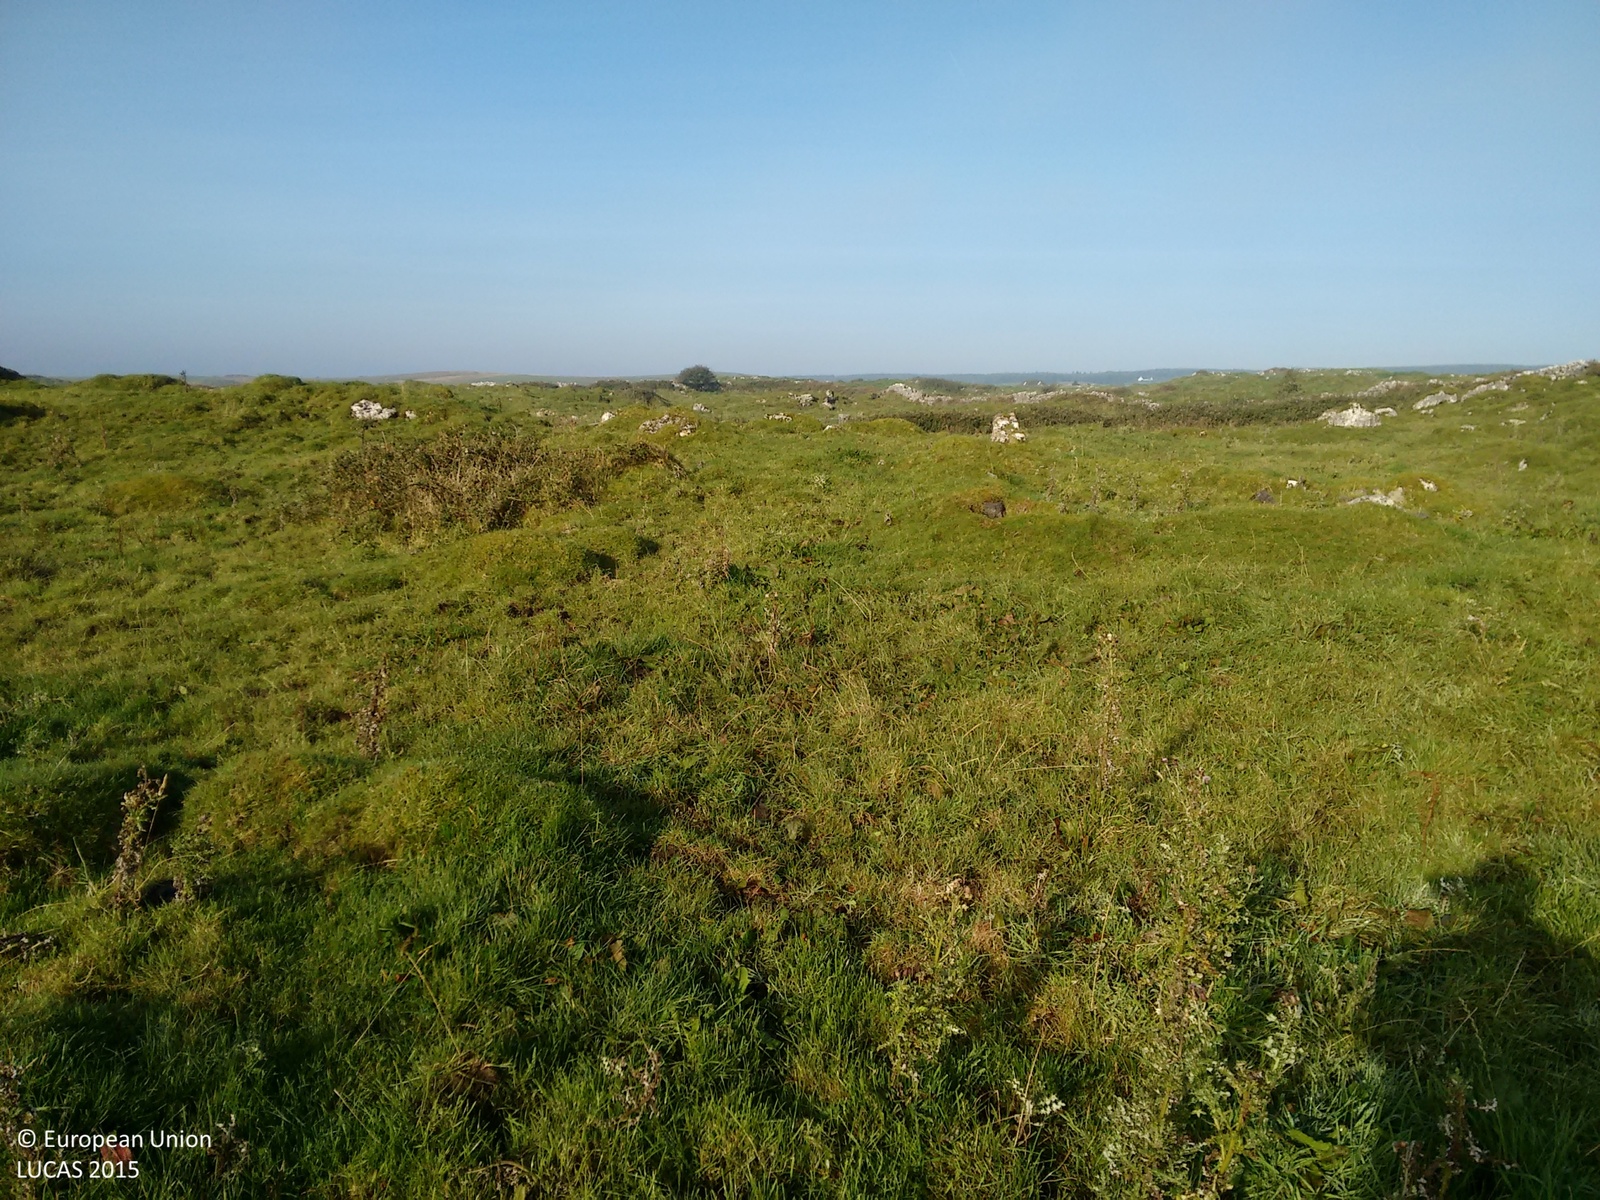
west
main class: Grassland
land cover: Grassland without tree/shrub cover
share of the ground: > 75 %
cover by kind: herbaceous plants 95 %, consolidated bare surface 5 %
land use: Agriculture (excluding fallow land and kitchen gardens)
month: September
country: IE
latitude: 53.0361
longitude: -9.2674
